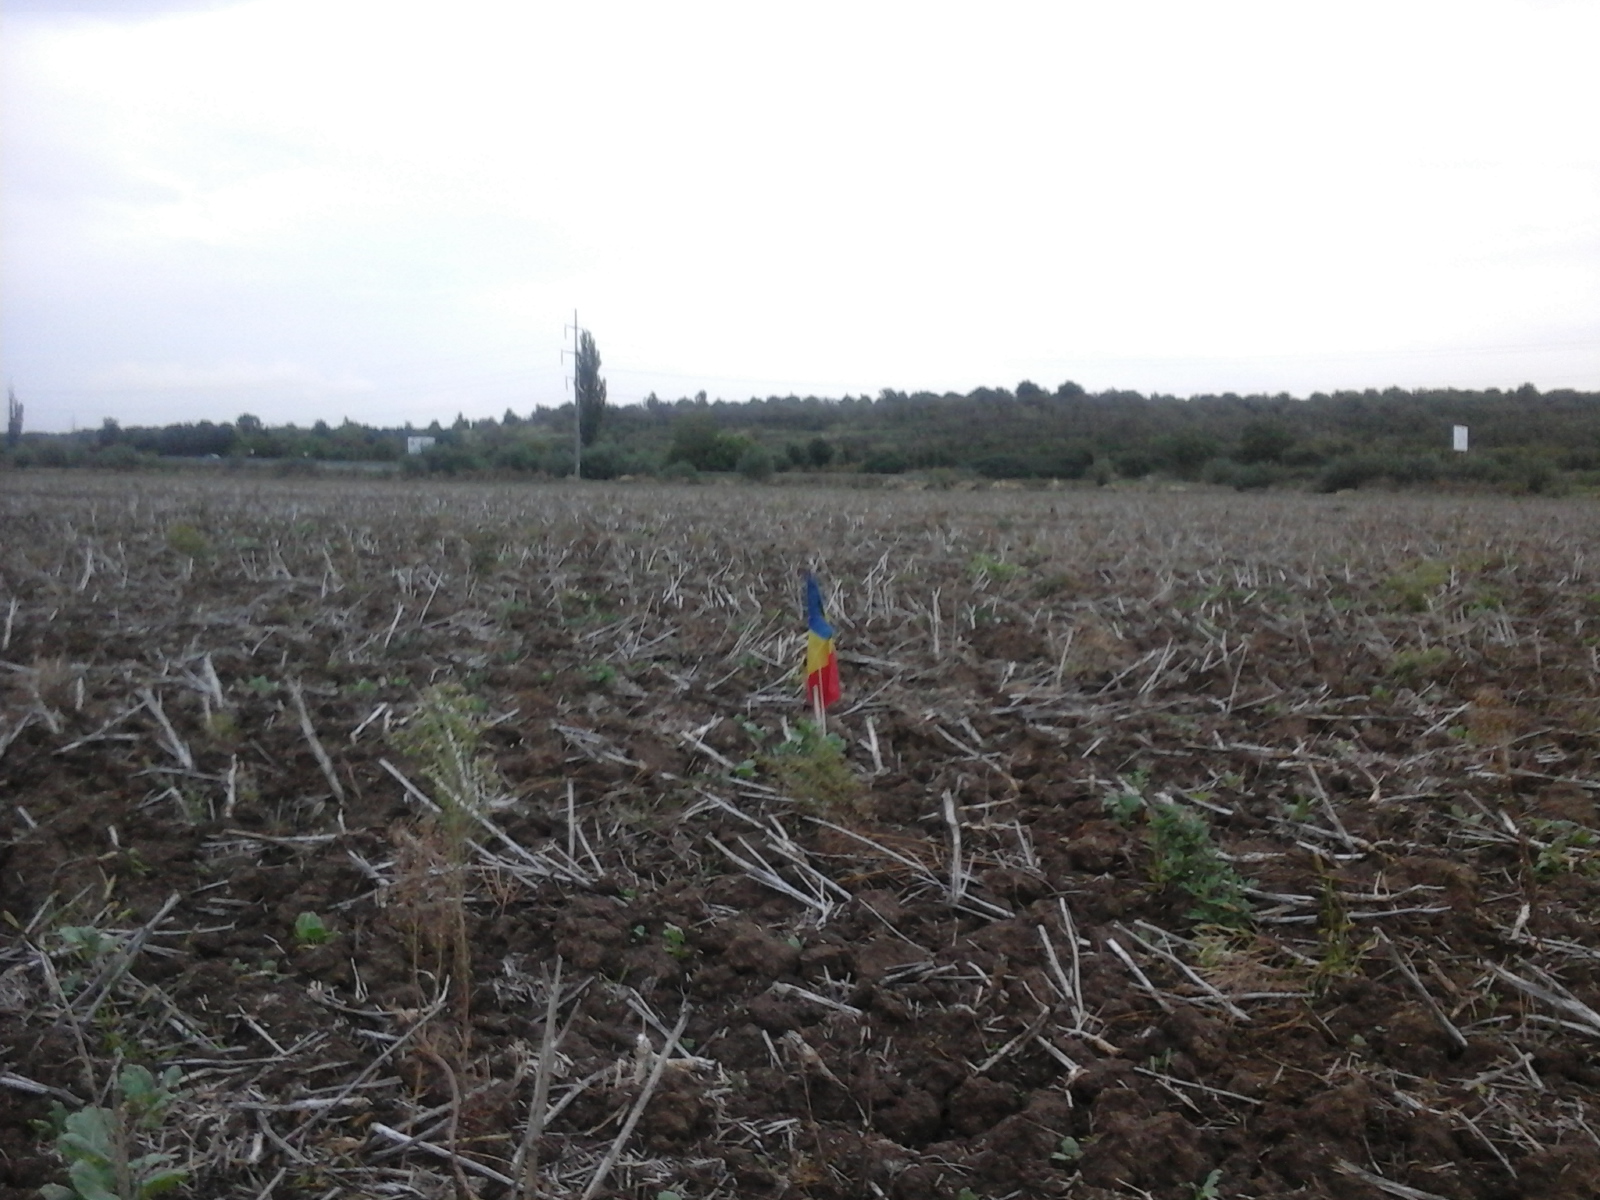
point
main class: Cropland
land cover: Rape and turnip rape
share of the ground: < 10 %
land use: Agriculture (excluding fallow land and kitchen gardens)
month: September
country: RO
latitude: 47.1221
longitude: 21.8960
